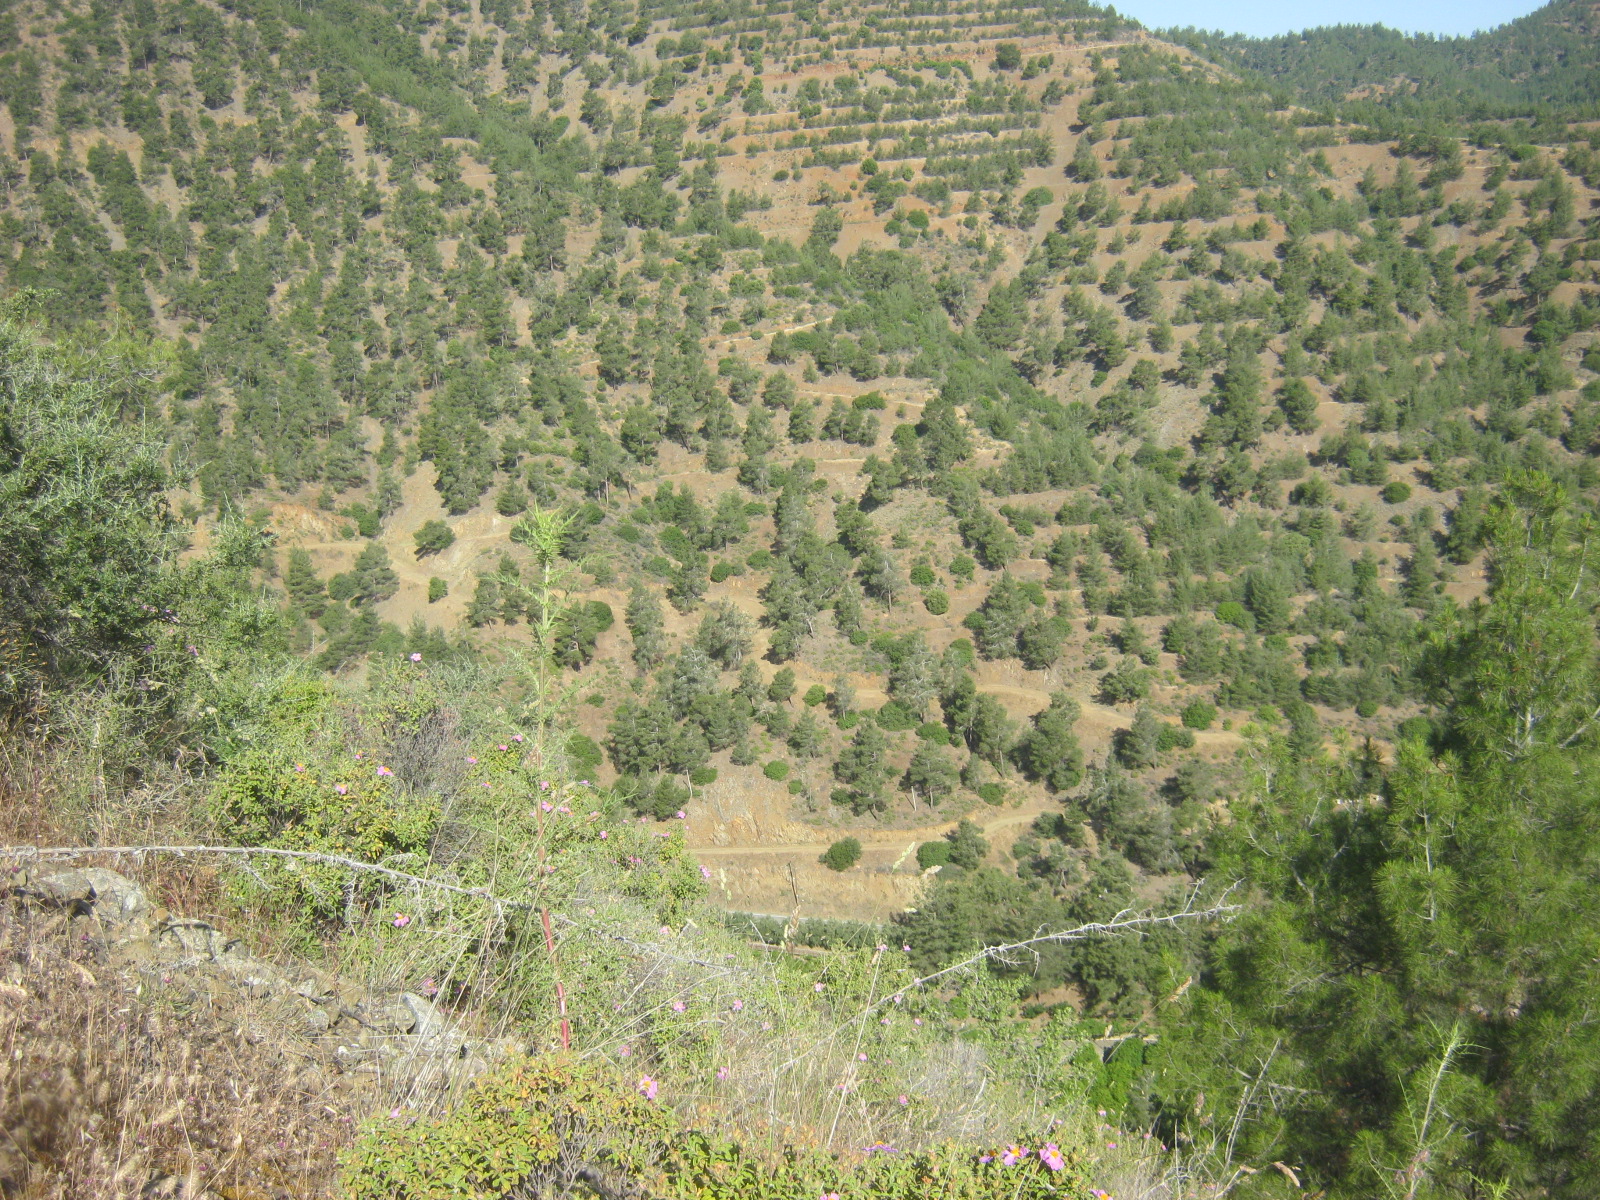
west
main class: Woodland
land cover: Pine dominated coniferous woodland
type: coniferous forest of the mediterranean region
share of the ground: 50 - 75 %
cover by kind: coniferous forest trees 50 %, shrubs 30 %, herbaceous plants 10 %, unconsolidated bare surface 10 %
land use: Forestry
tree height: > 5 m
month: May
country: CY
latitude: 35.0439
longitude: 32.8284
